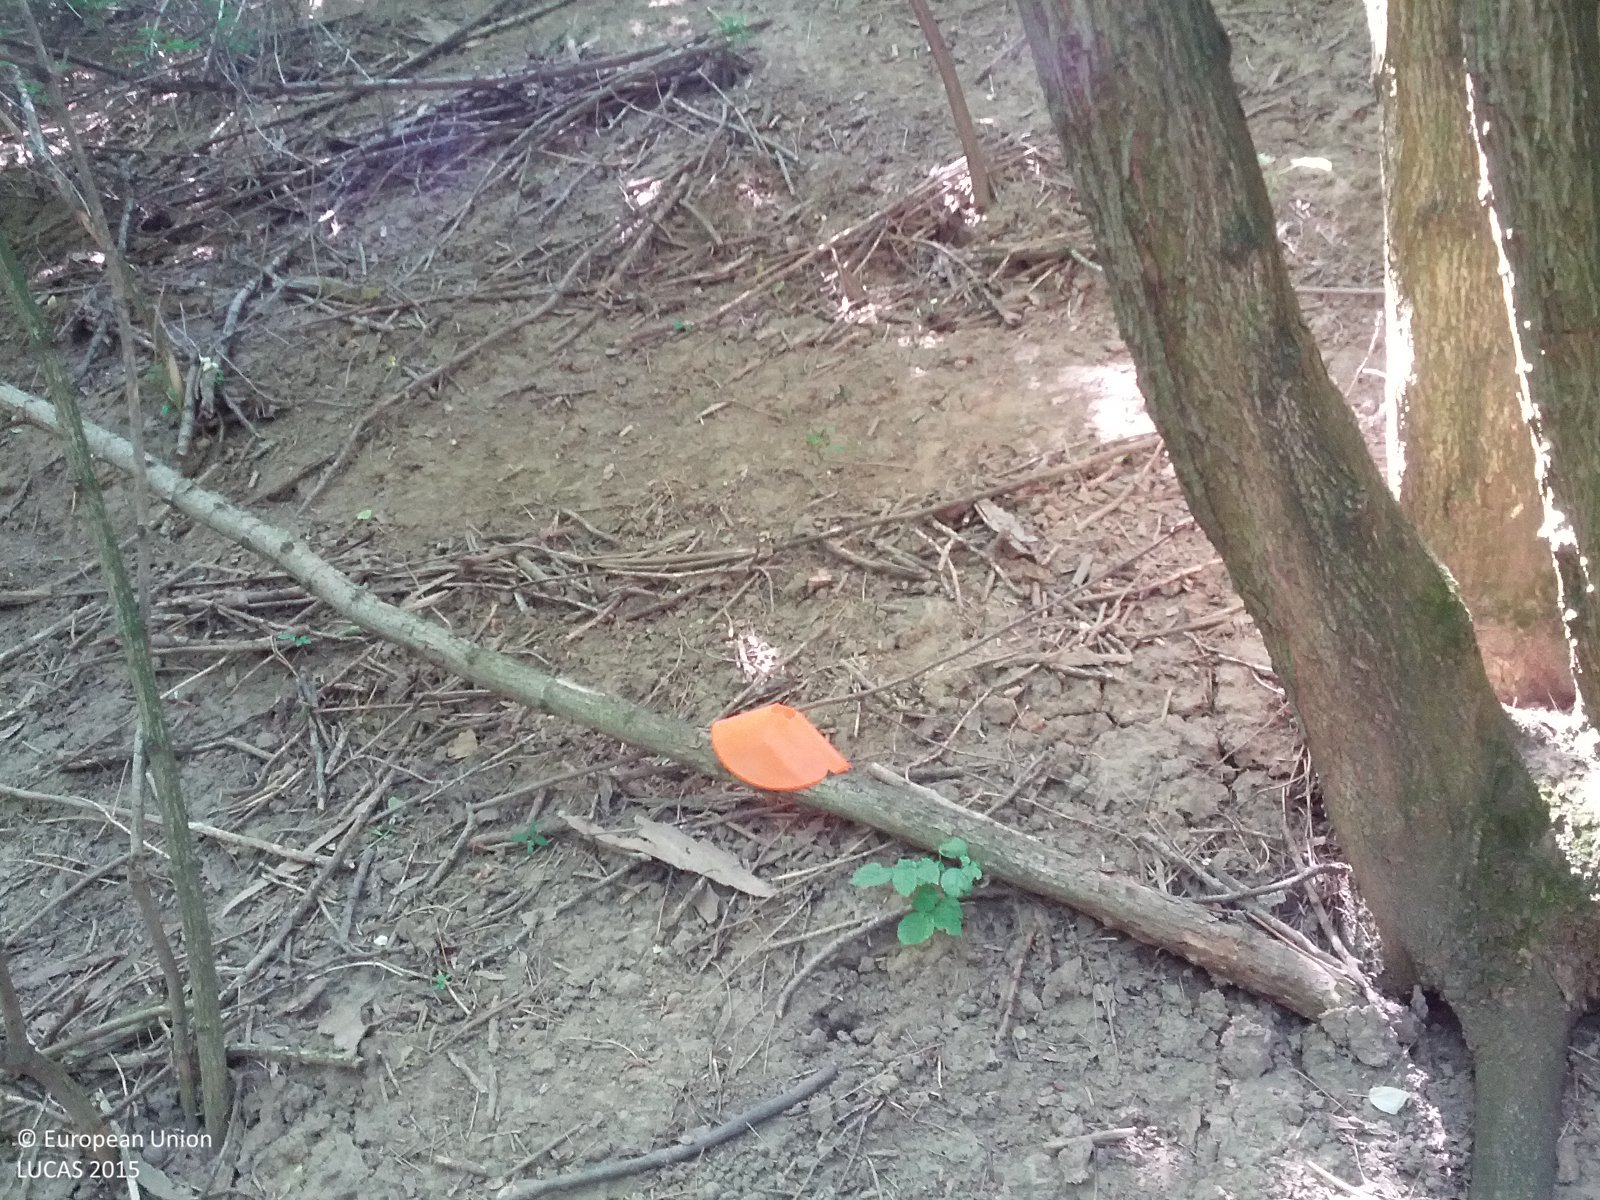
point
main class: Woodland
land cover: Broadleaved woodland
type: acidophilous oak and oak-birch forest
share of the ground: > 75 %
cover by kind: broadleaved forest trees 90 %, unconsolidated bare surface 10 %
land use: Forestry
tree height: > 5 m
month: July
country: AT
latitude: 48.5359
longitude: 16.8197
